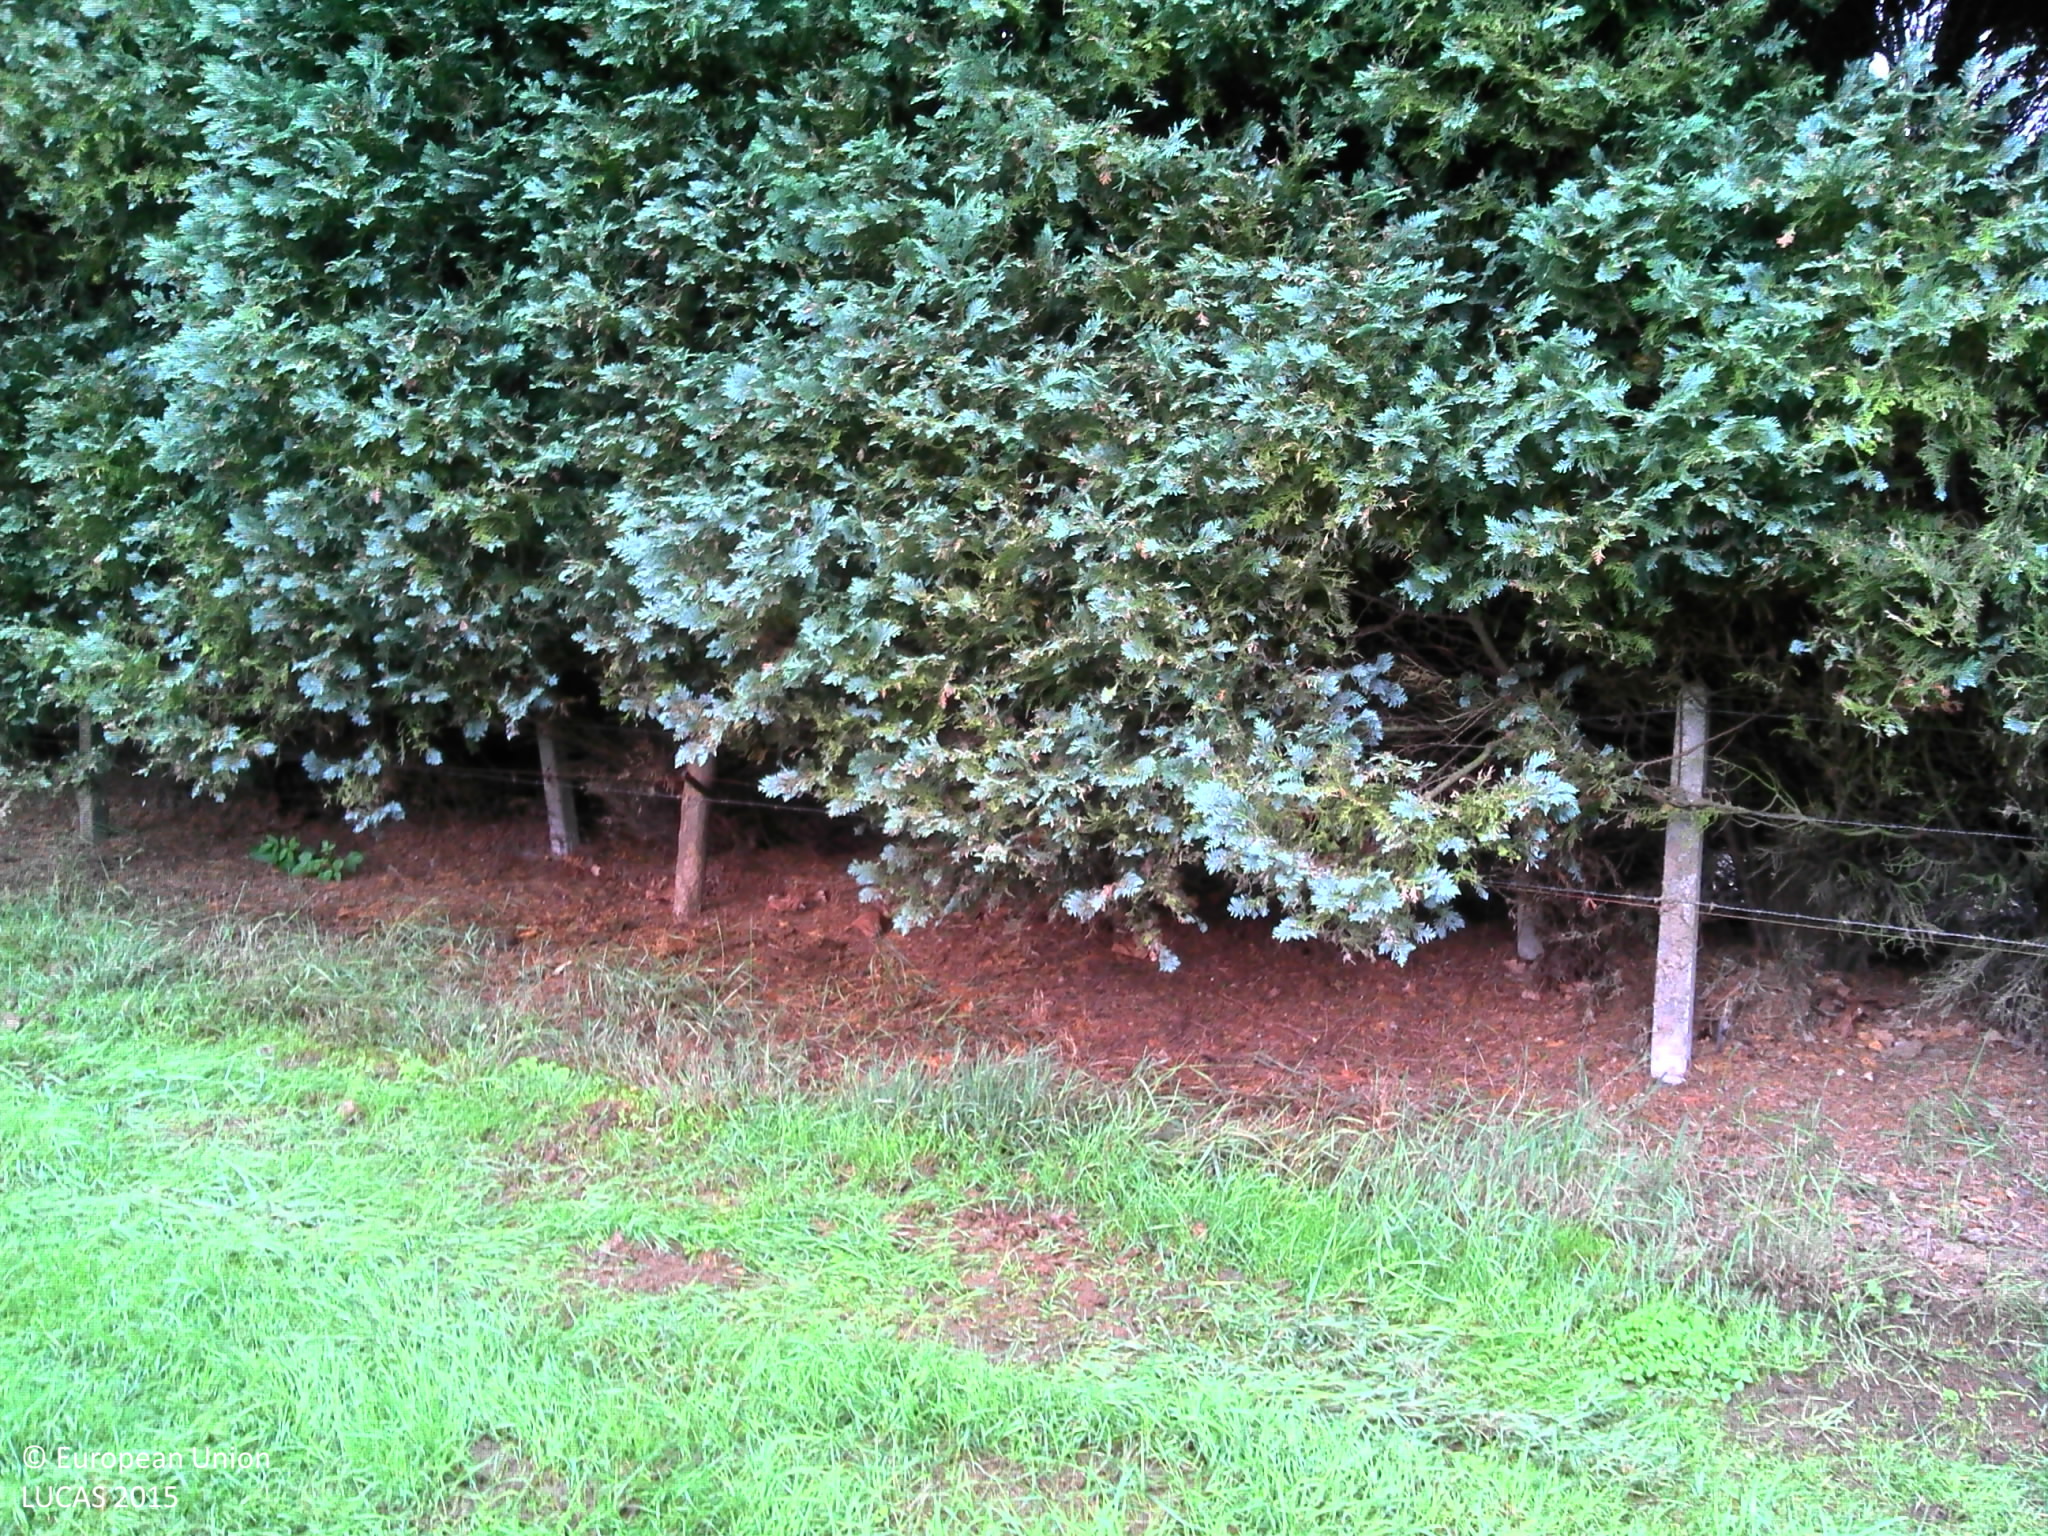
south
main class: Grassland
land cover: Grassland without tree/shrub cover
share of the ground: > 75 %
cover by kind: herbaceous plants 100 %
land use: Agriculture (excluding fallow land and kitchen gardens)
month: August
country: BE
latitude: 51.3041
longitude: 5.1061
